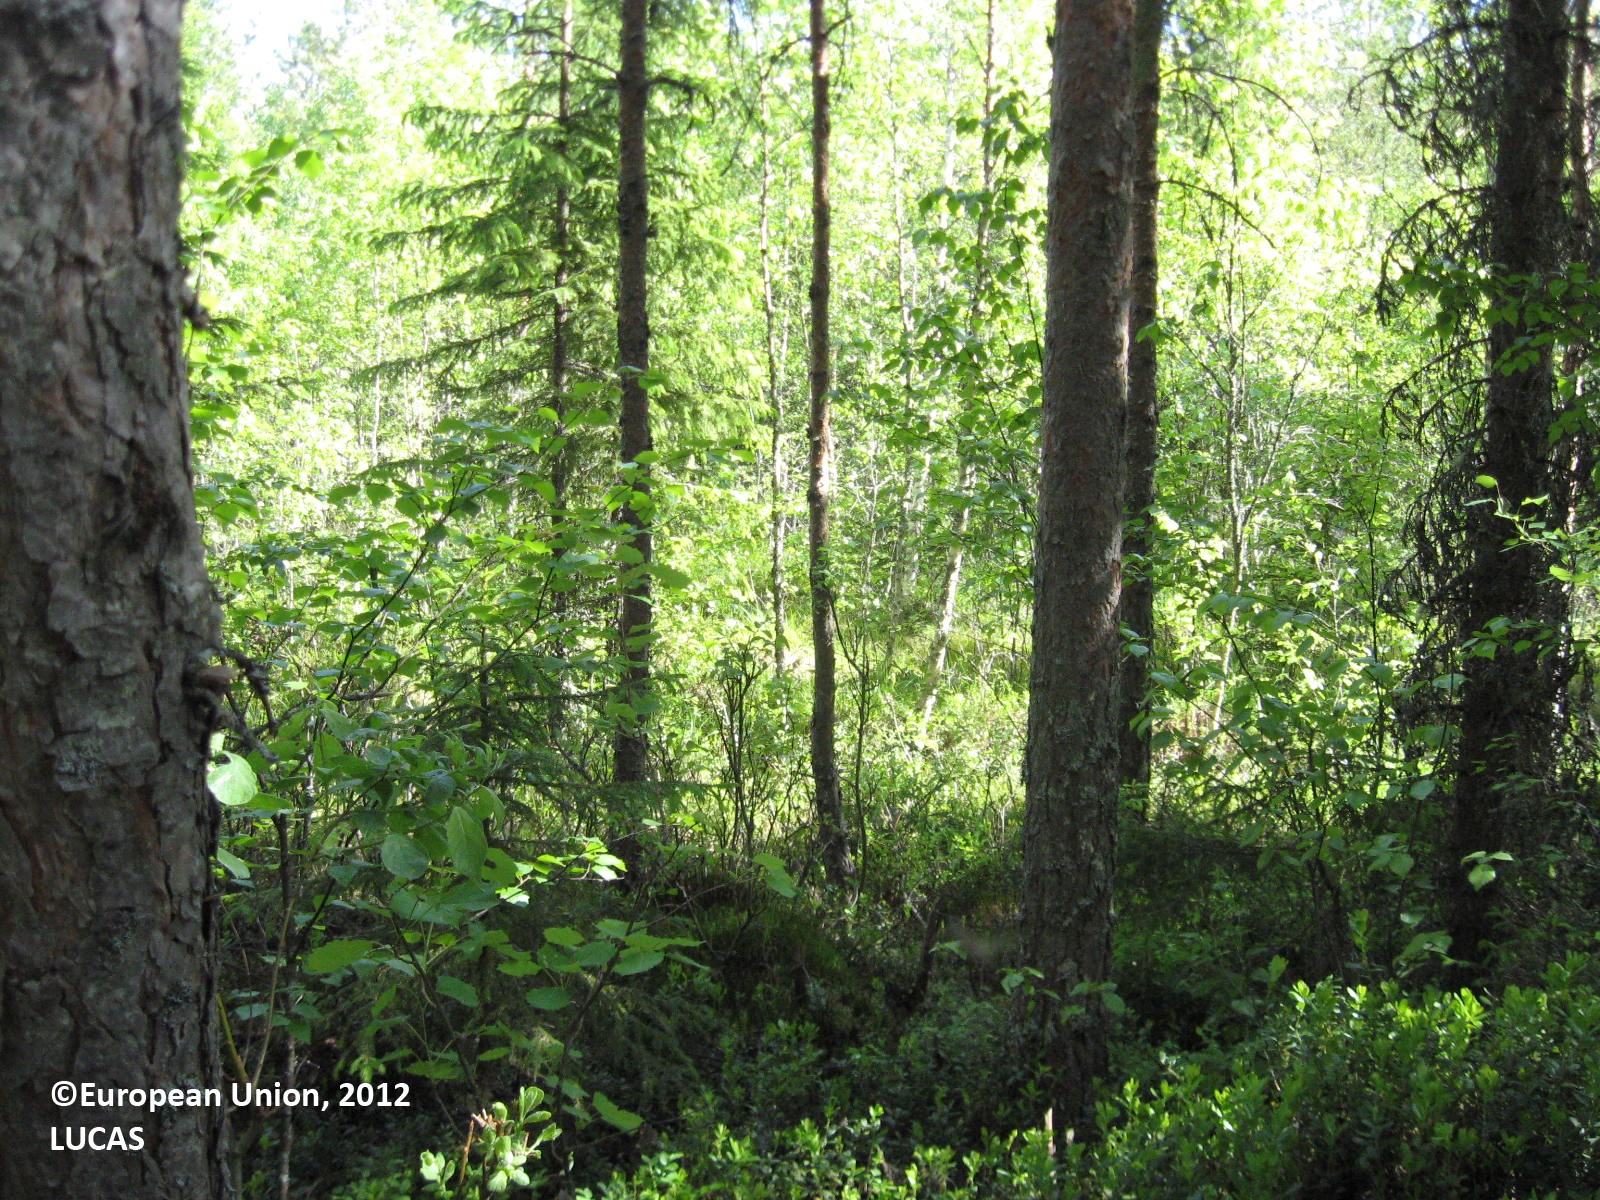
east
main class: Woodland
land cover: Pine dominated mixed woodland
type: boreal forest
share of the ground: > 75 %
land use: Forestry
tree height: > 5 m
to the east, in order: Pine dominated mixed woodland; Ditches and canals; Pine dominated coniferous woodland; Ditches and canals; Spruce dominated mixed woodland
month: June
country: FI
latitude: 62.6987
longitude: 21.5135
